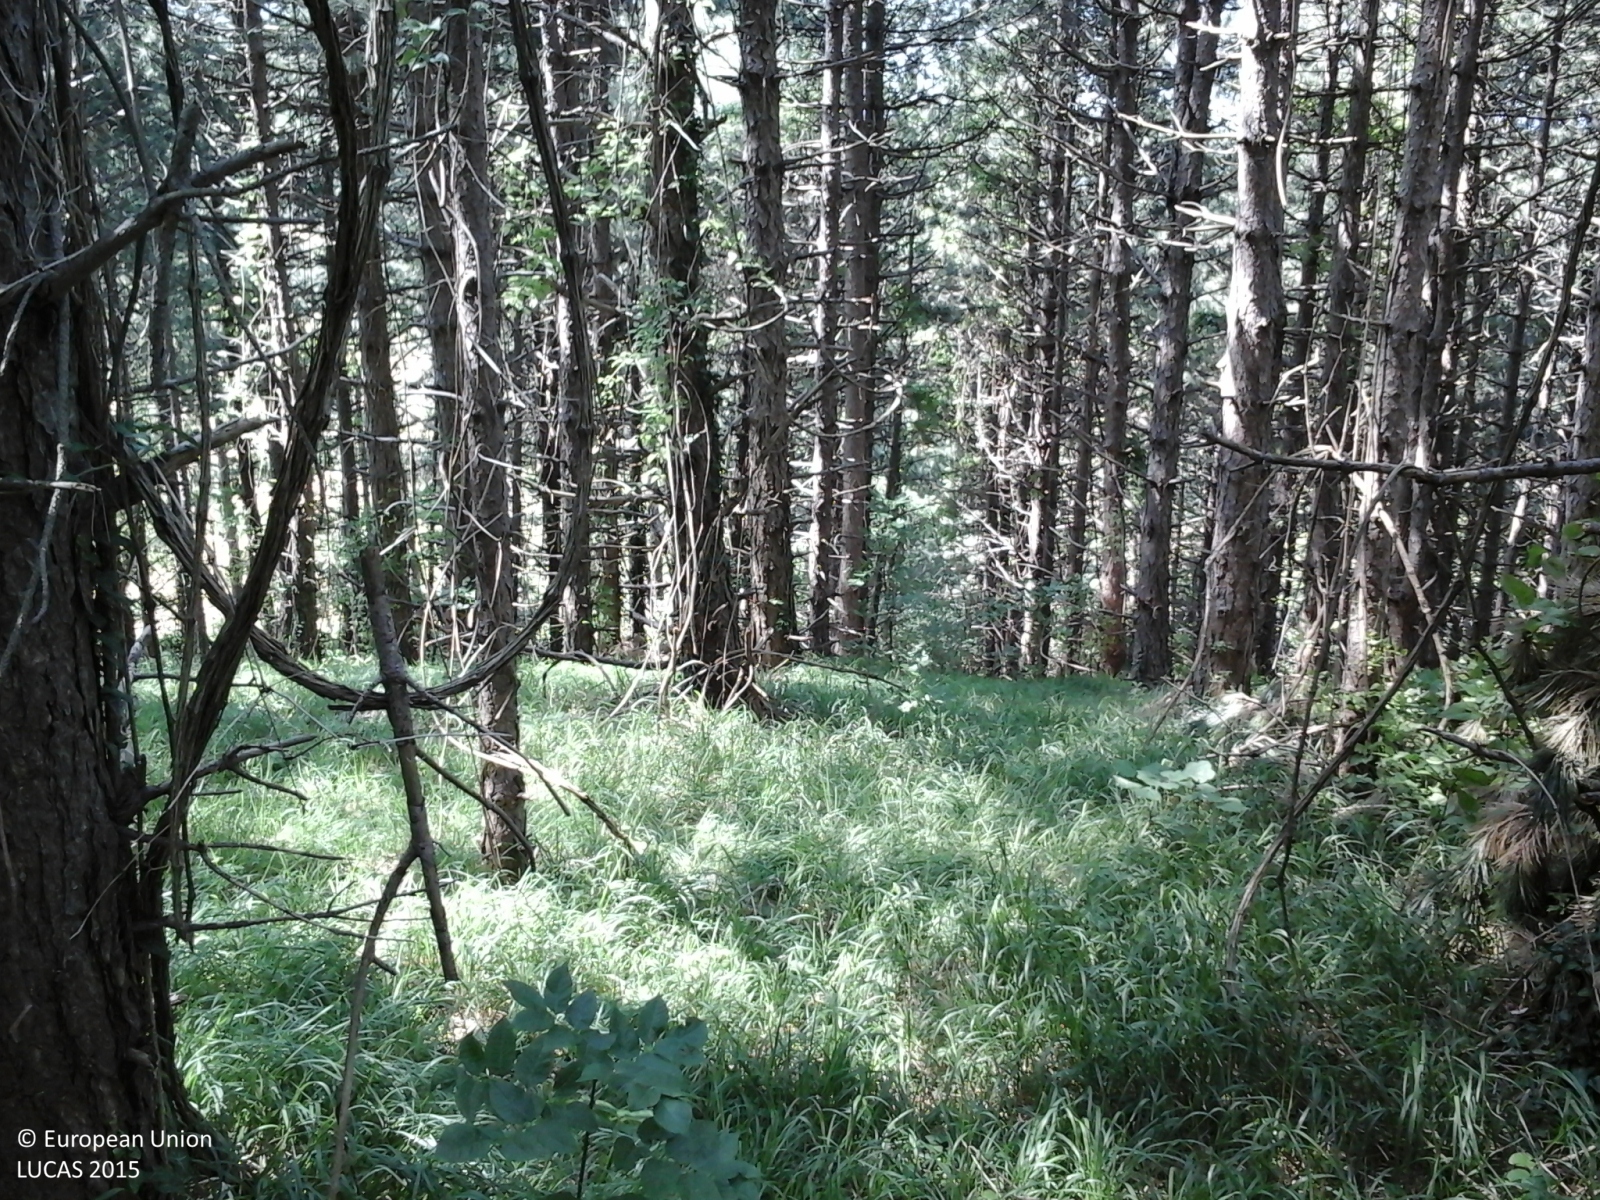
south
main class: Woodland
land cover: Pine dominated coniferous woodland
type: hemiboreal forest and nemoral coniferous forest and mixed broadleaved-coniferous forest
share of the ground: > 75 %
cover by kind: coniferous forest trees 100 %
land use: Forestry
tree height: > 5 m
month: June
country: IT
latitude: 44.1392
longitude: 11.6337
